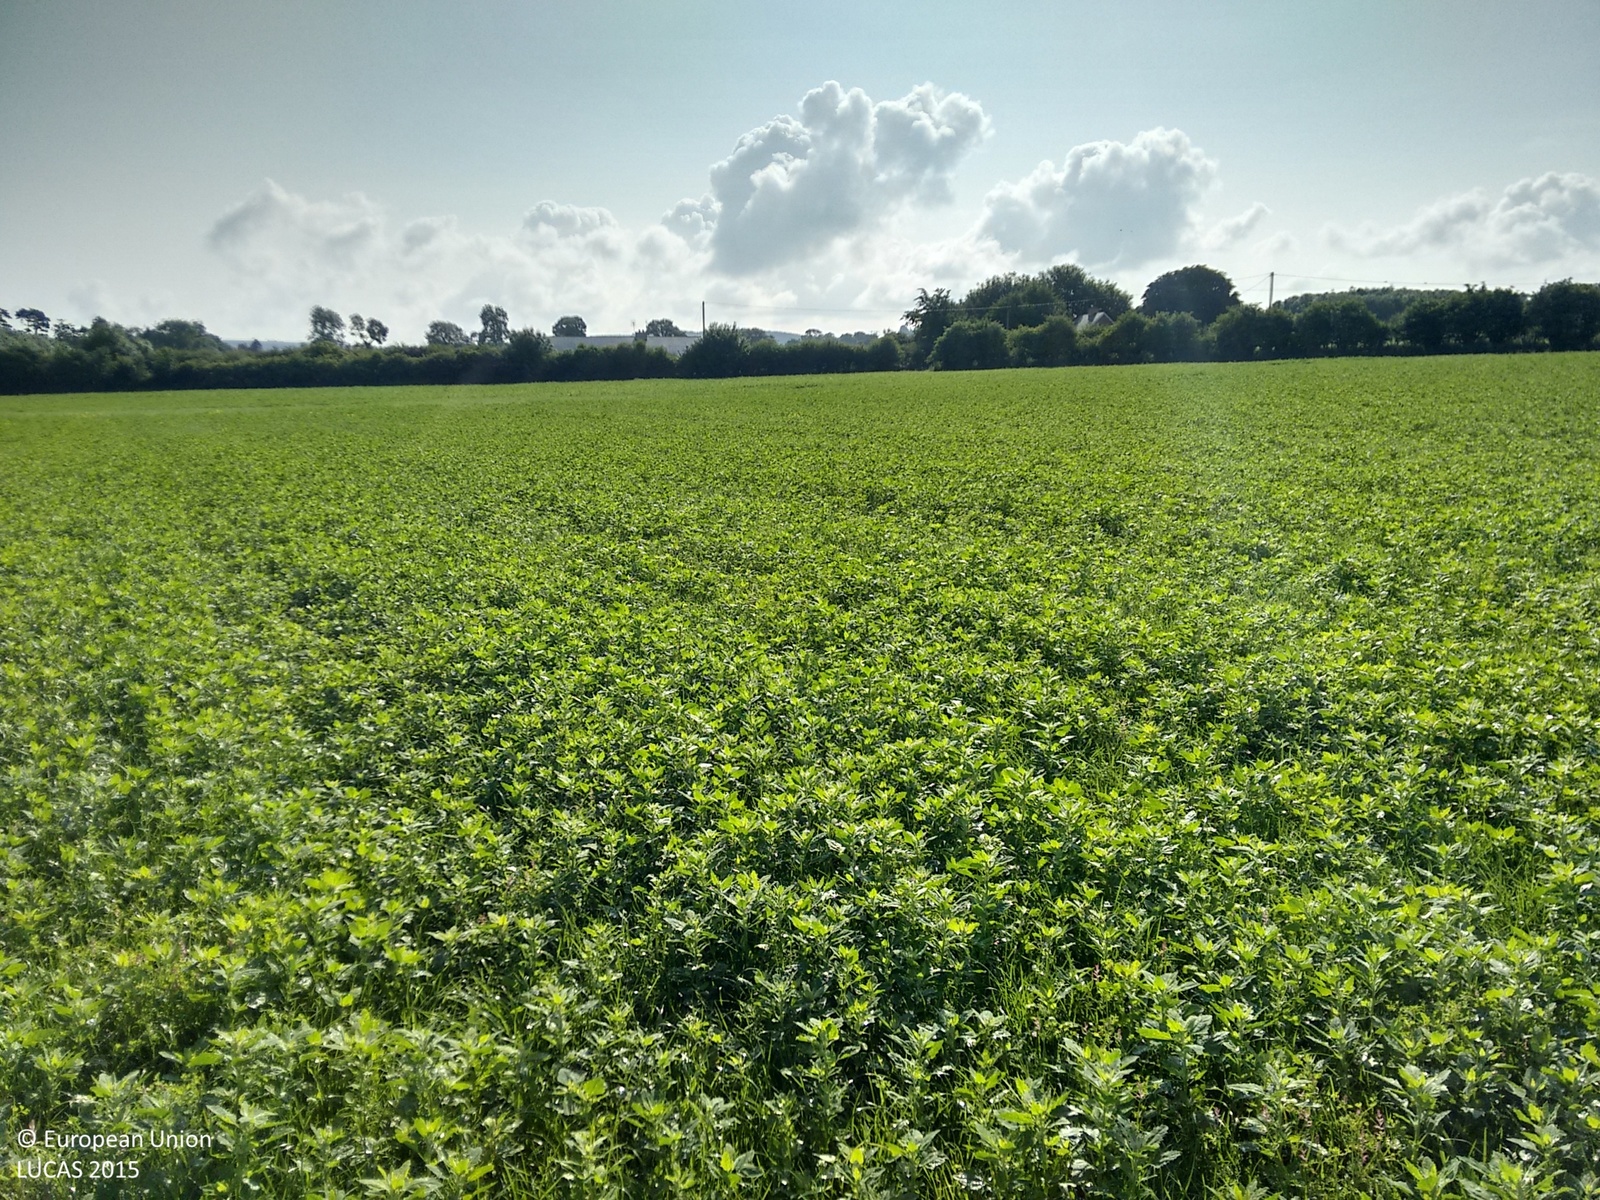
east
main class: Cropland
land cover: Temporary grasslands
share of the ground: > 75 %
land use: Agriculture (excluding fallow land and kitchen gardens)
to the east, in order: Temporary grasslands; Abandoned hedges; Grass margins; Artificial constructions in urban areas; Grassland without tree/shrub cover
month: July
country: IE
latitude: 52.5782
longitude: -7.7122
